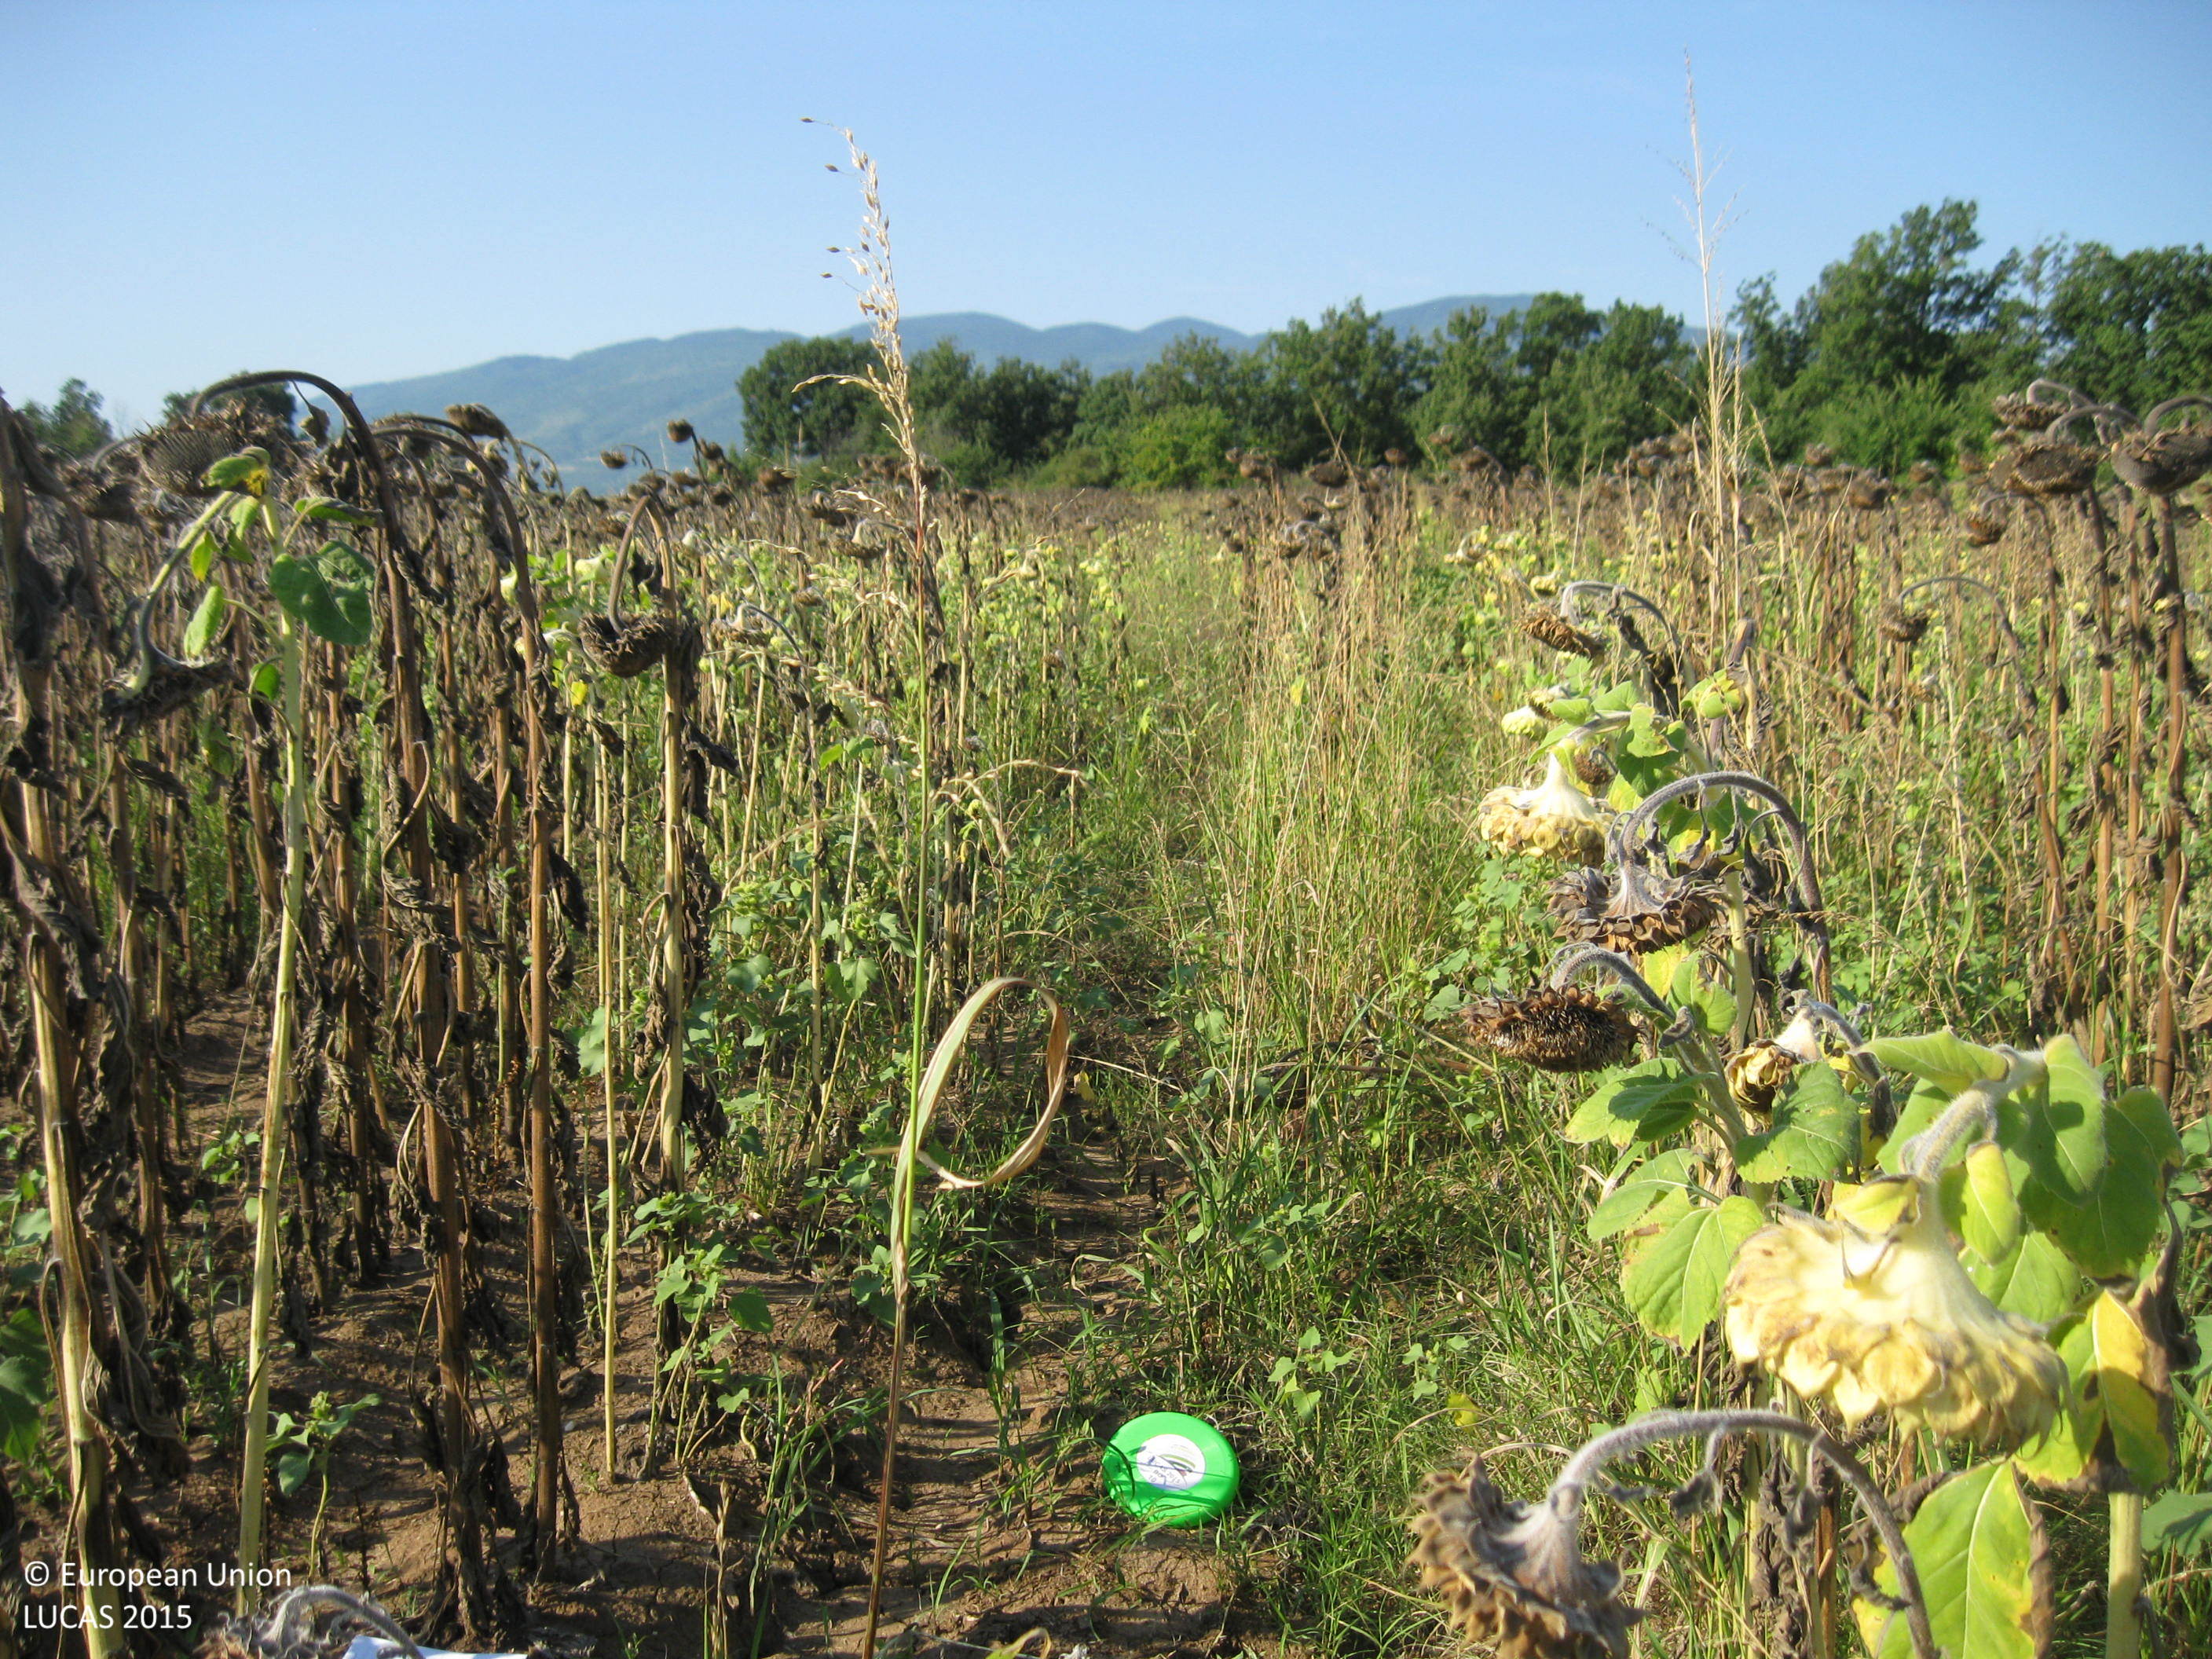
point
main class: Cropland
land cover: Sunflower
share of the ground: > 75 %
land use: Agriculture (excluding fallow land and kitchen gardens)
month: August
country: BG
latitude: 42.0115
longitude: 24.9664
